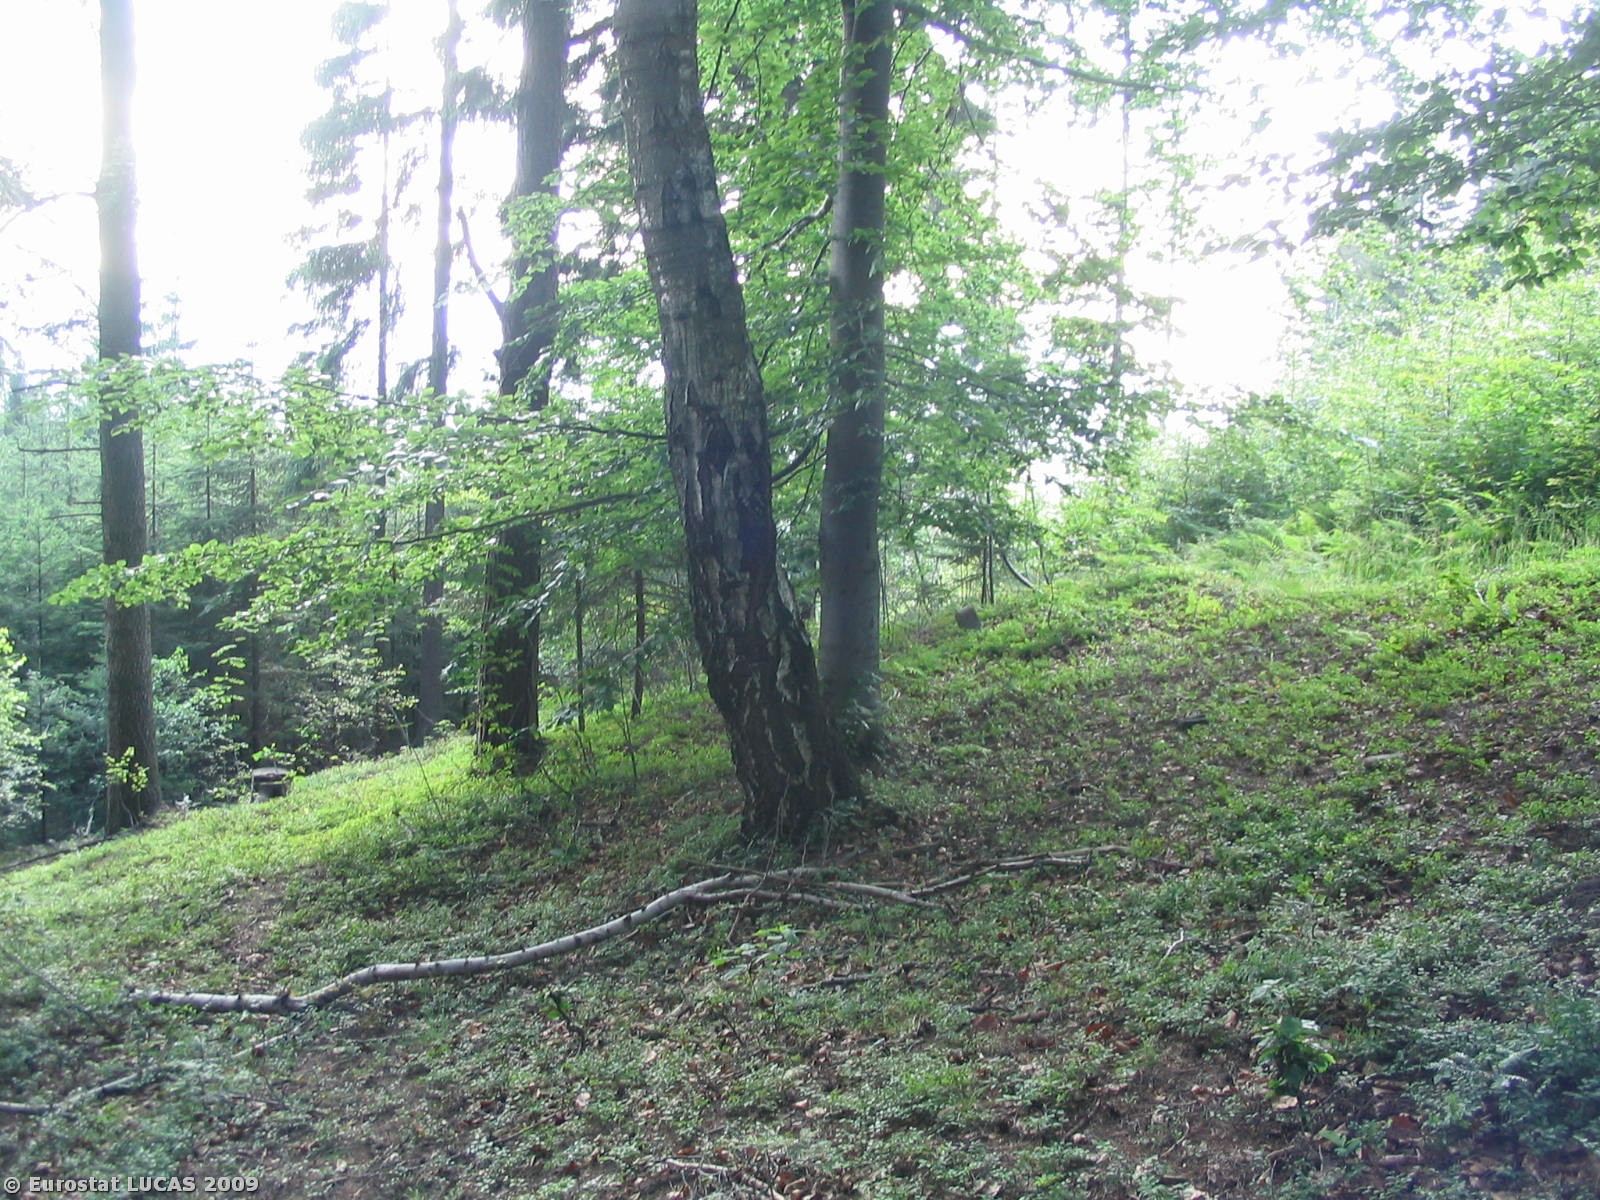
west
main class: Woodland
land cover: Mixed woodland
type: hemiboreal forest and nemoral coniferous forest and mixed broadleaved-coniferous forest
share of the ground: > 75 %
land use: Forestry
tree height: > 5 m
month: July
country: CZ
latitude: 49.6119
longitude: 18.7533
